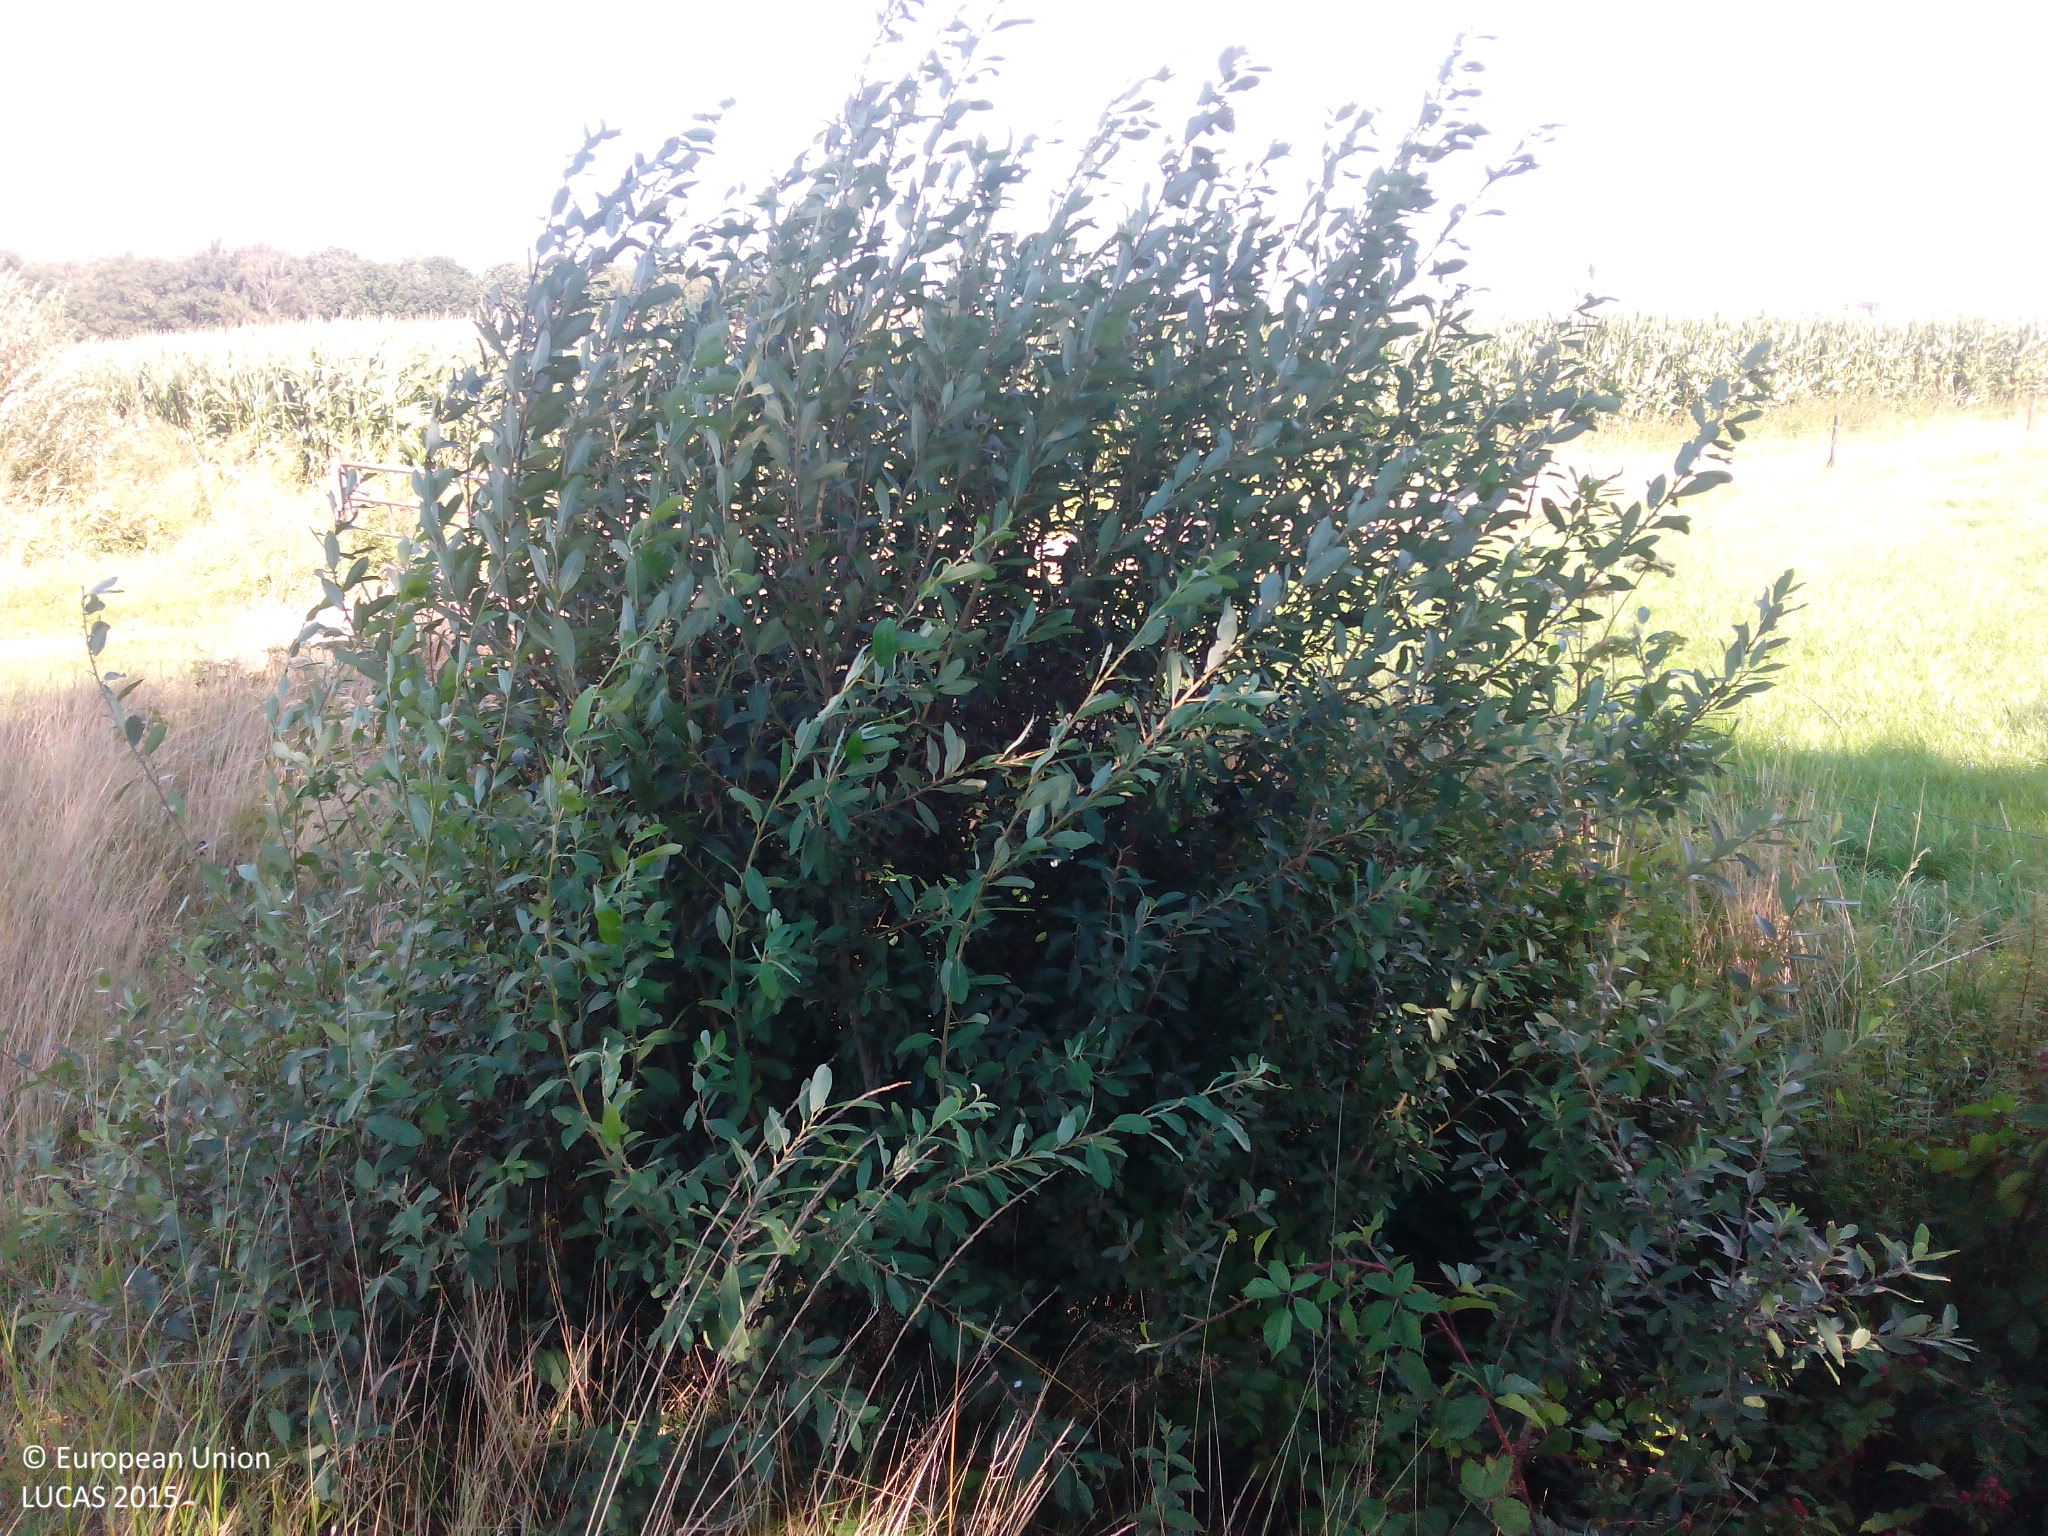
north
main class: Cropland
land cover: Maize
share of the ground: > 75 %
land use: Agriculture (excluding fallow land and kitchen gardens)
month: August
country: NL
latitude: 51.3099
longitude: 5.7091
